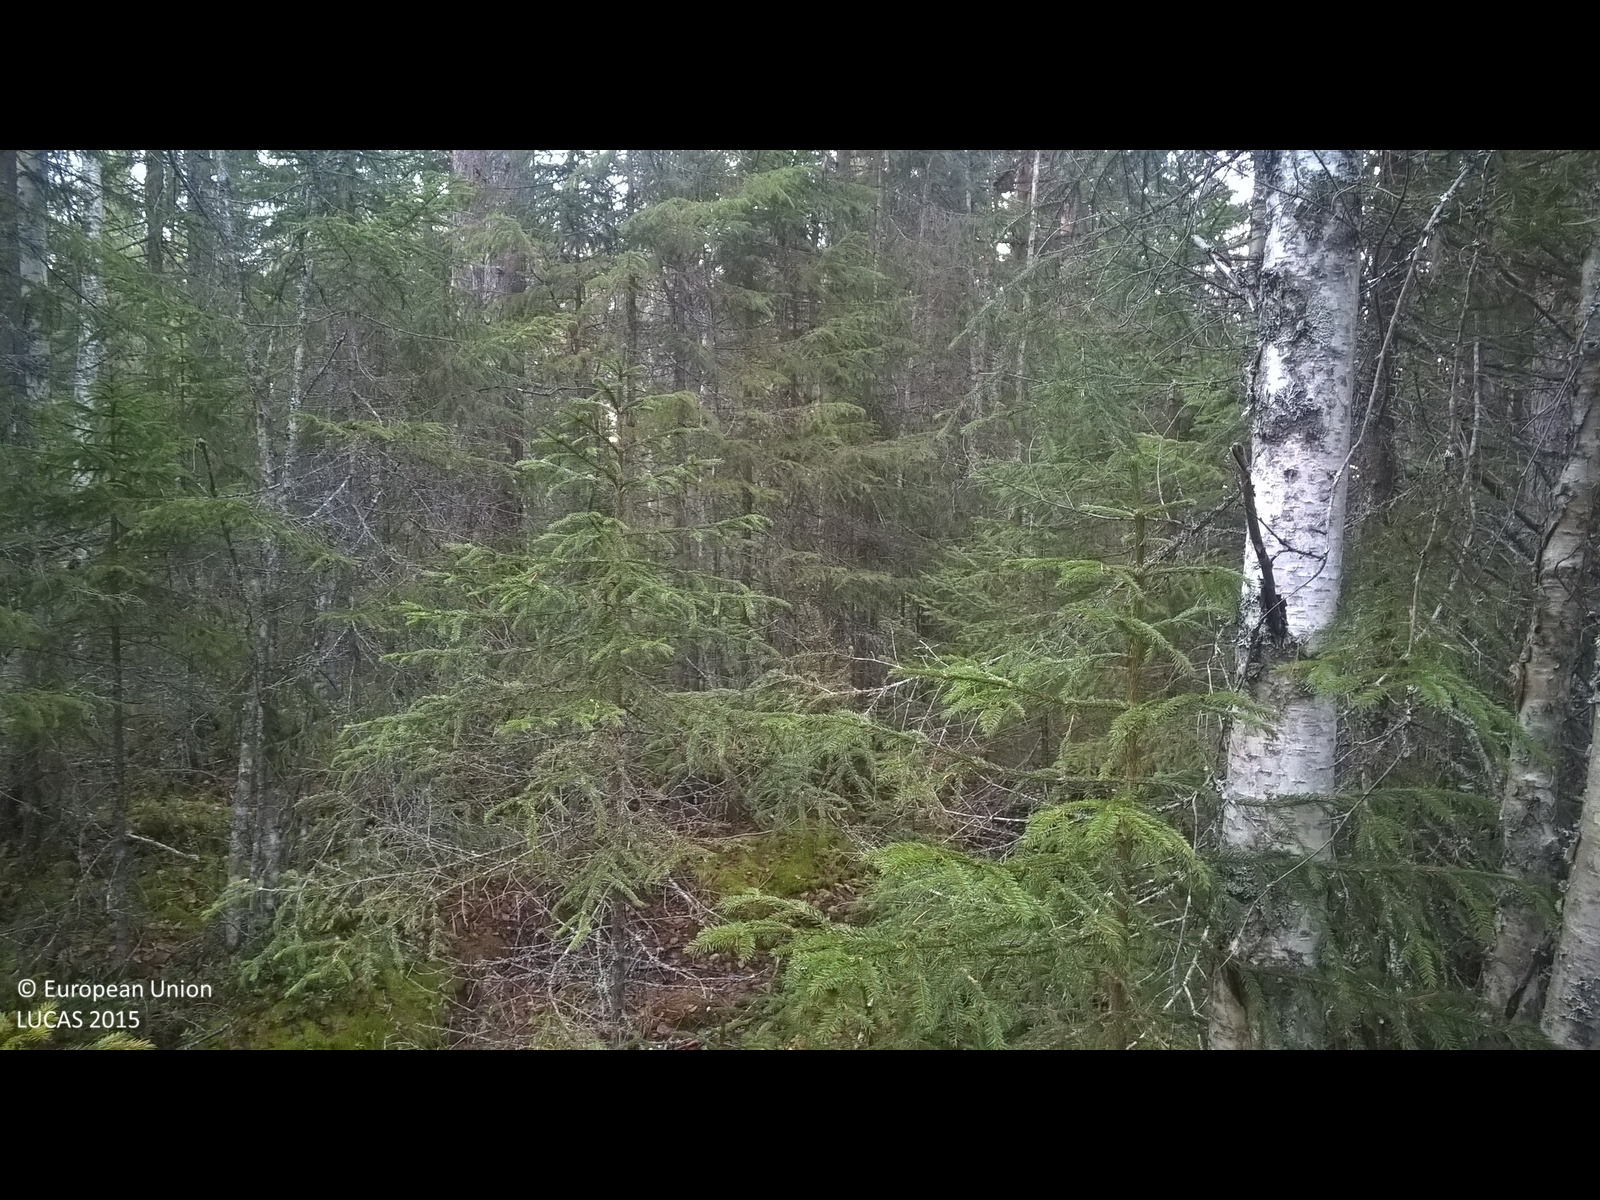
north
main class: Woodland
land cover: Spruce dominated coniferous woodland
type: boreal forest
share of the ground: > 75 %
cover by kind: coniferous forest trees 75 %, lichens and mosses 15 %, broadleaved forest trees 10 %
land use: Forestry
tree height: > 5 m
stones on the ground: < 10 %
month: November
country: SE
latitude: 62.7471
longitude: 14.9711
